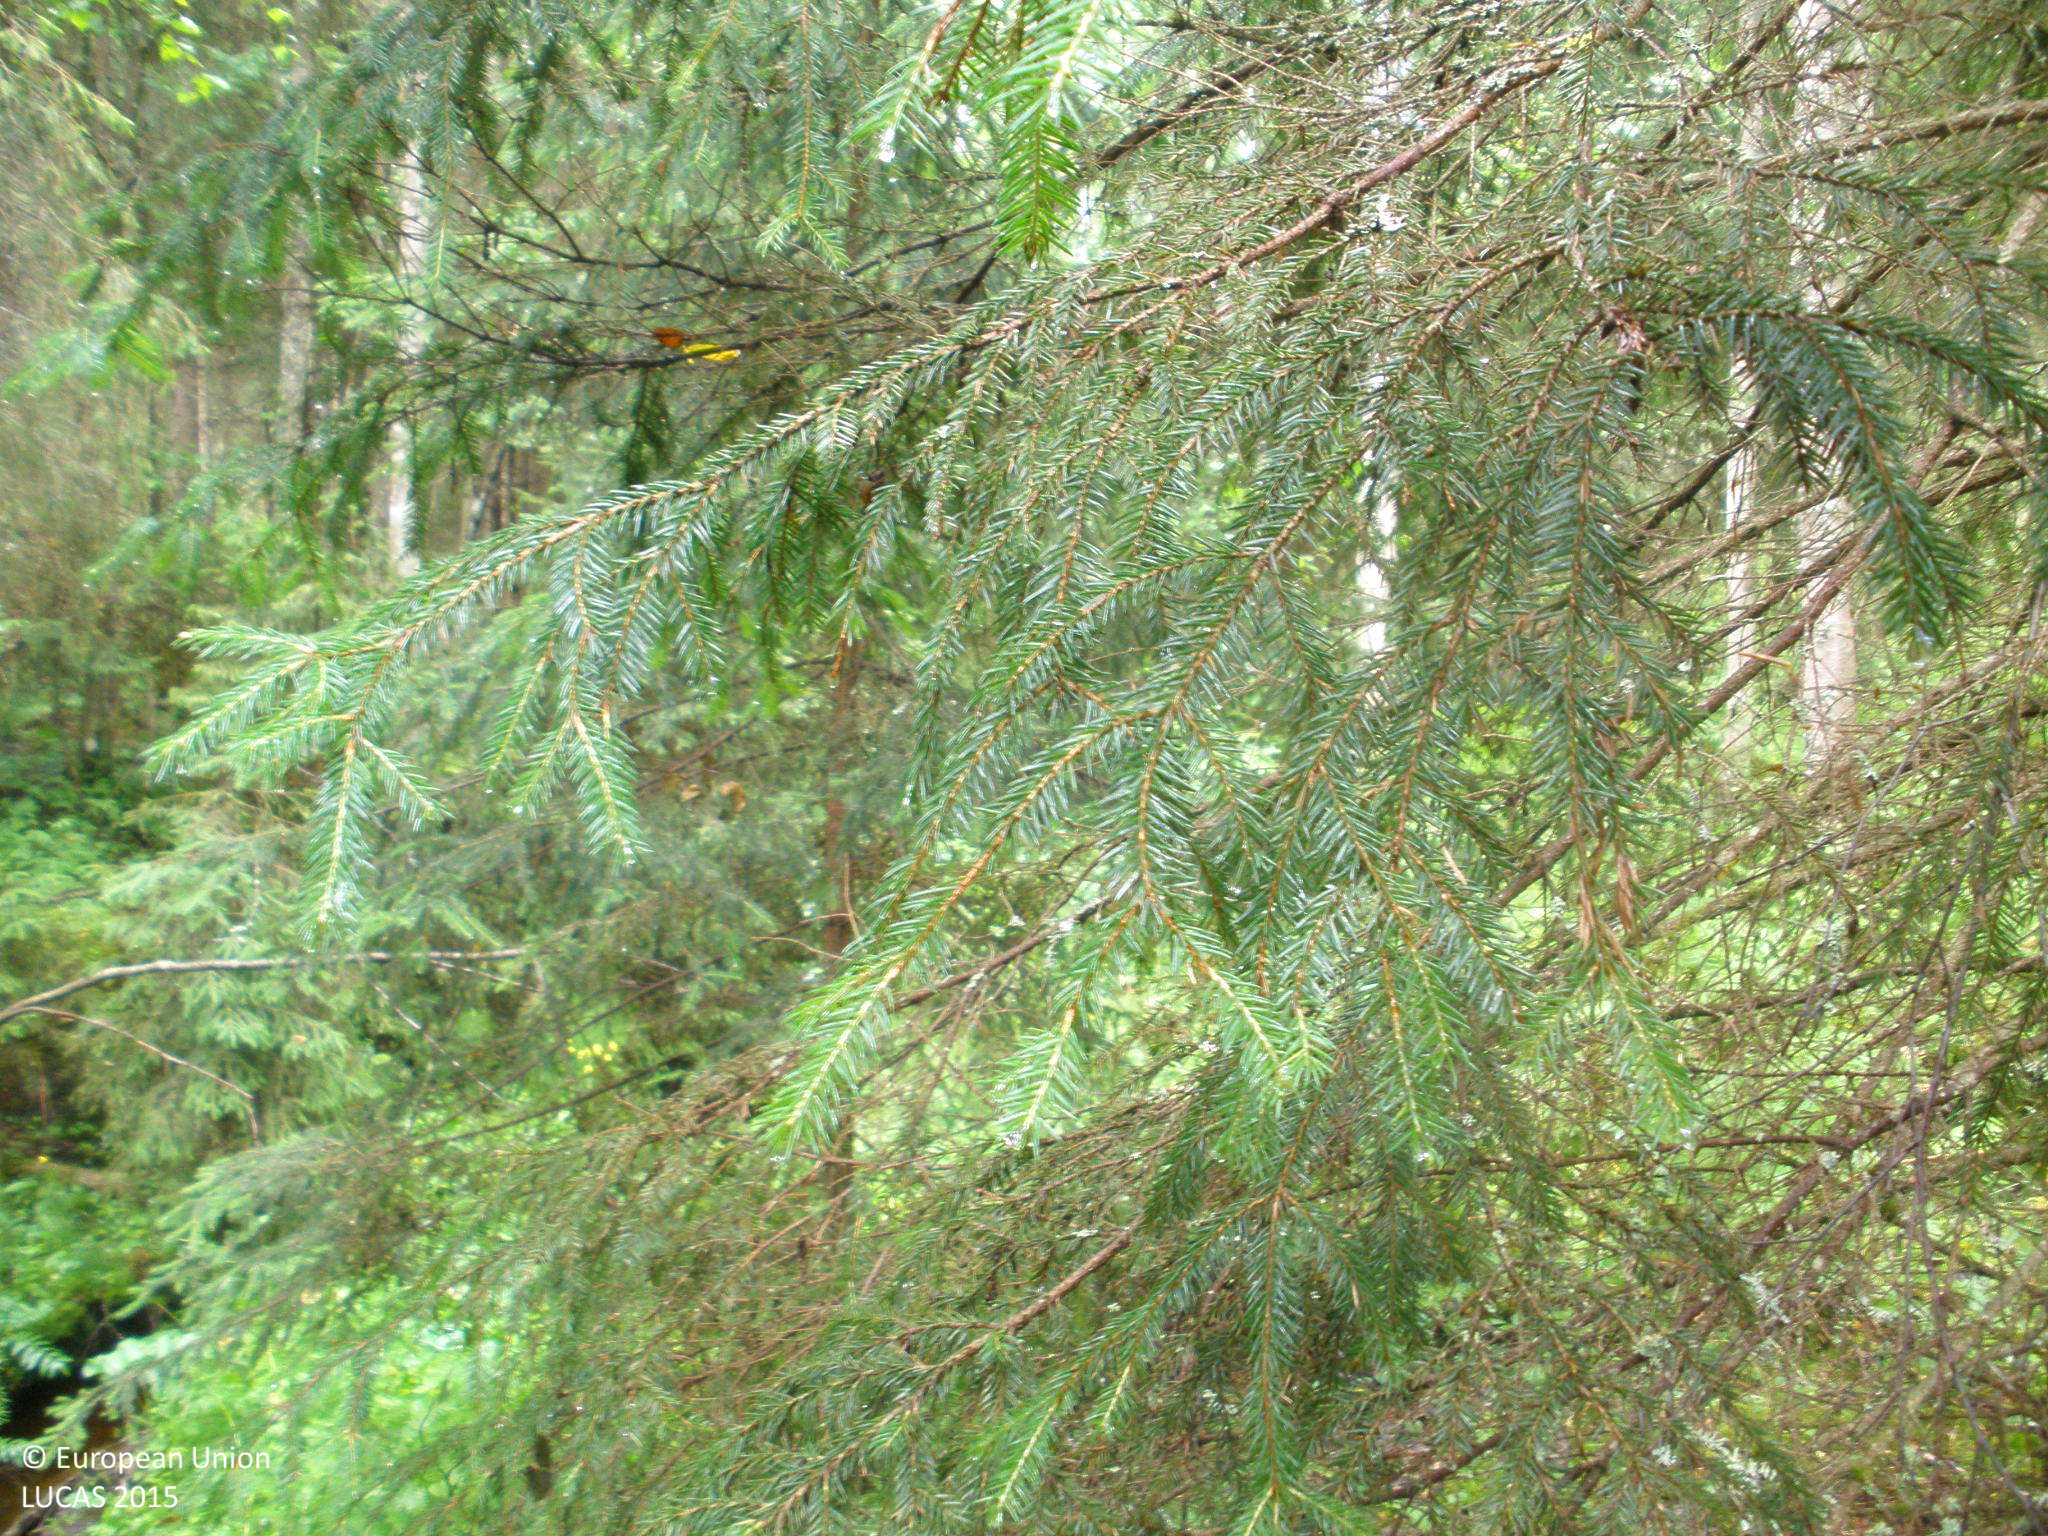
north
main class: Woodland
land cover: Spruce dominated mixed woodland
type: boreal forest
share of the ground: > 75 %
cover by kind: coniferous forest trees 40 %, broadleaved forest trees 40 %, herbaceous plants 10 %, lichens and mosses 10 %
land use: Forestry
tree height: > 5 m
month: July
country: FI
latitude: 61.0191
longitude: 24.8940
